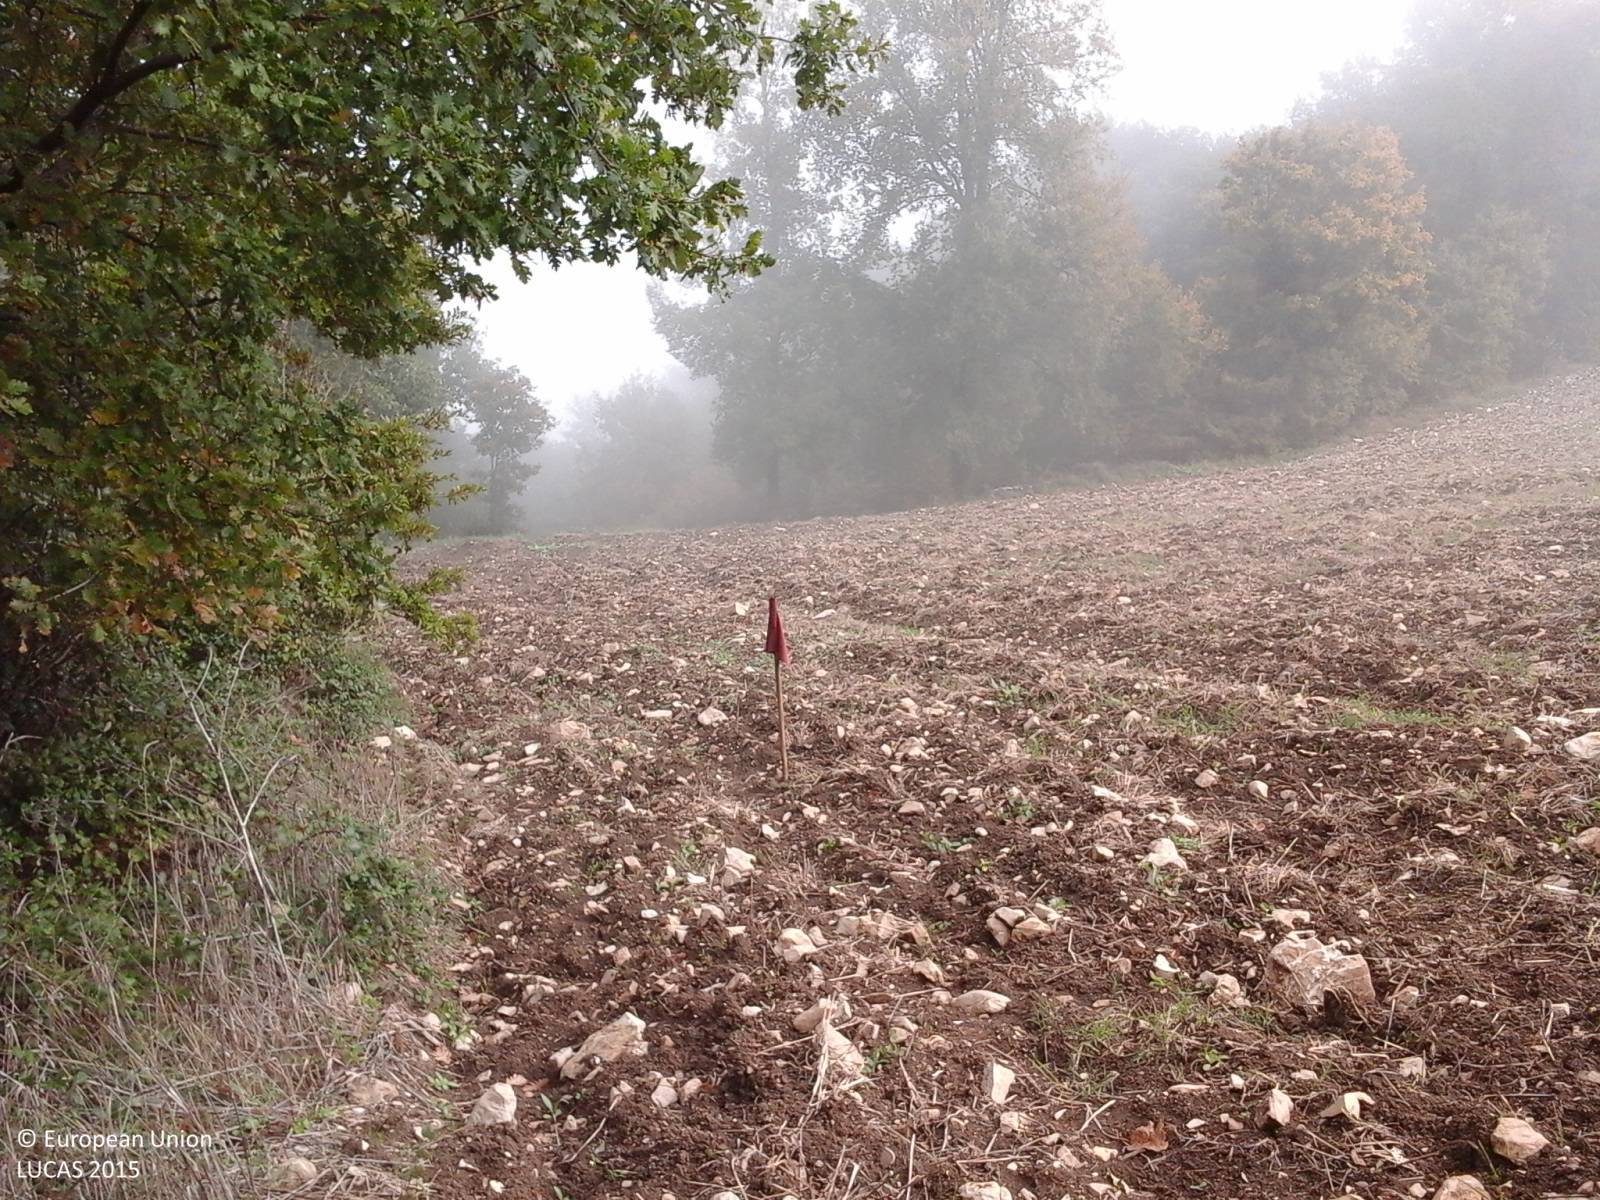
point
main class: Cropland
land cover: Durum wheat
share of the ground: < 10 %
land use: Agriculture (excluding fallow land and kitchen gardens)
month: October
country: IT
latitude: 42.7527
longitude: 12.3750
